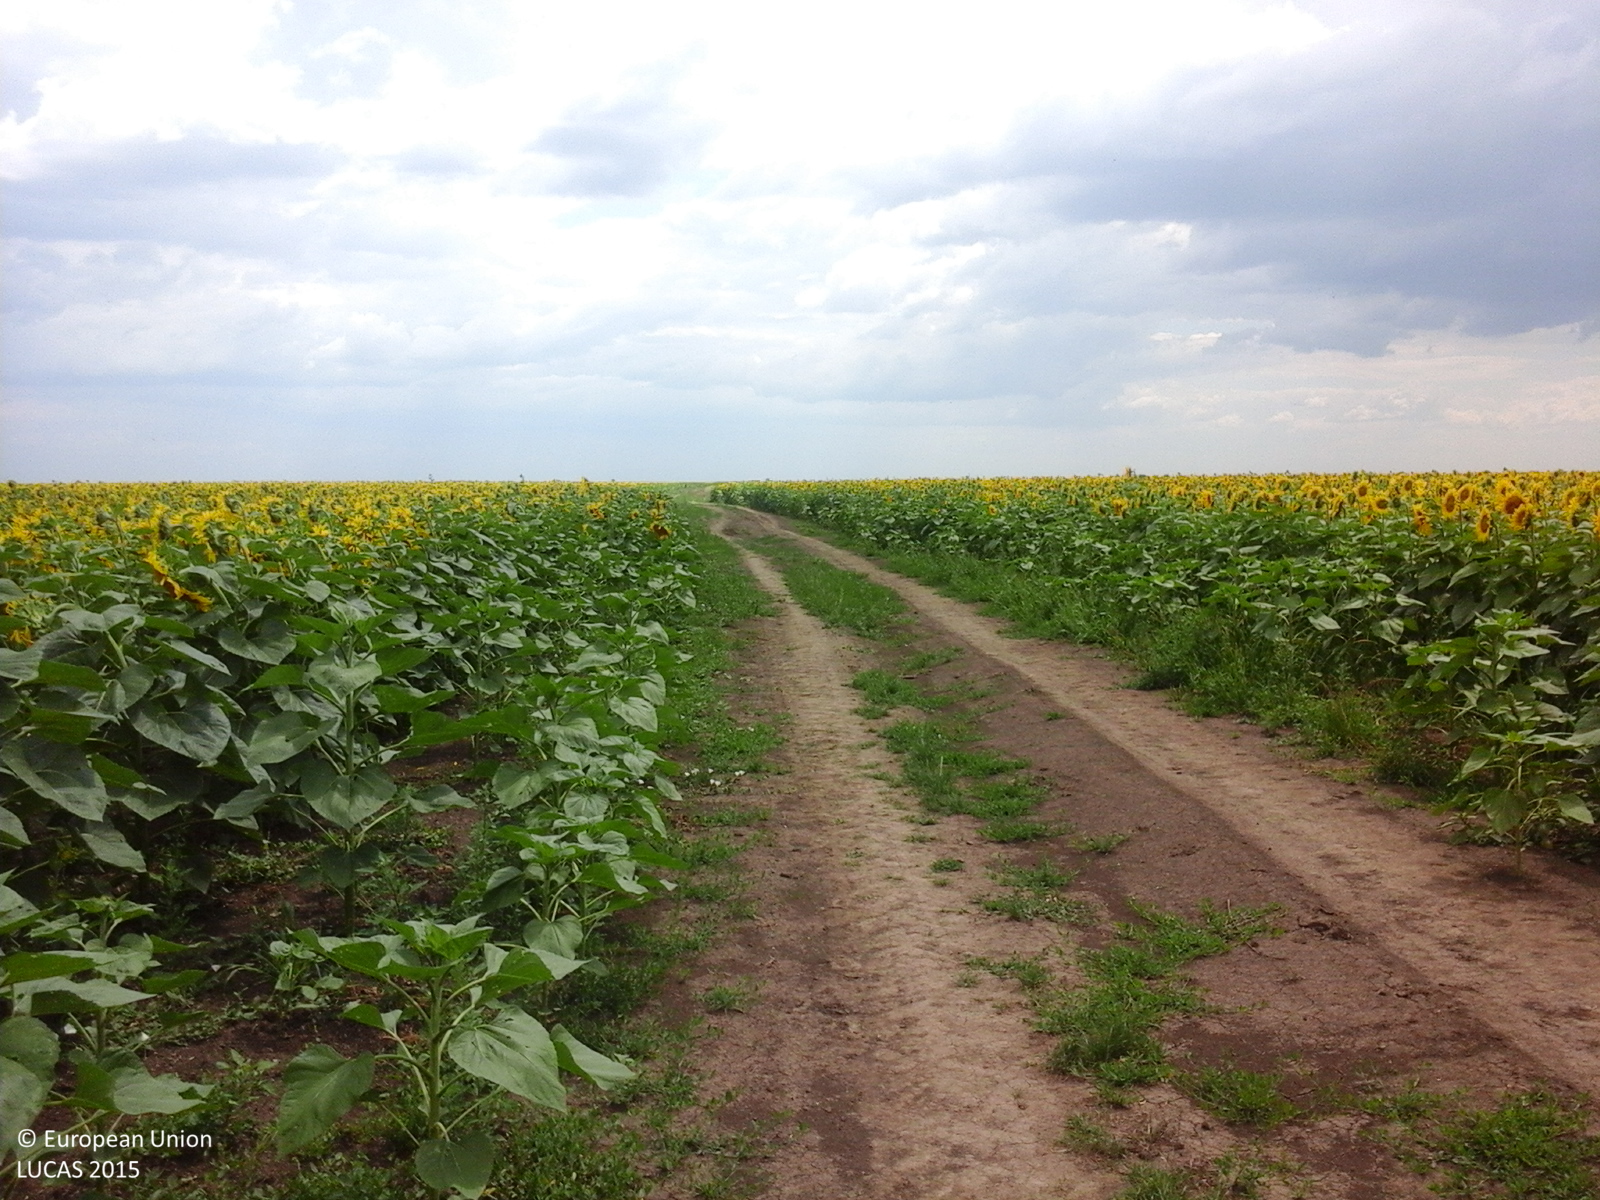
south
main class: Cropland
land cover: Sunflower
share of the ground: > 75 %
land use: Agriculture (excluding fallow land and kitchen gardens)
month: July
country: RO
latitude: 44.0389
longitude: 24.8870
